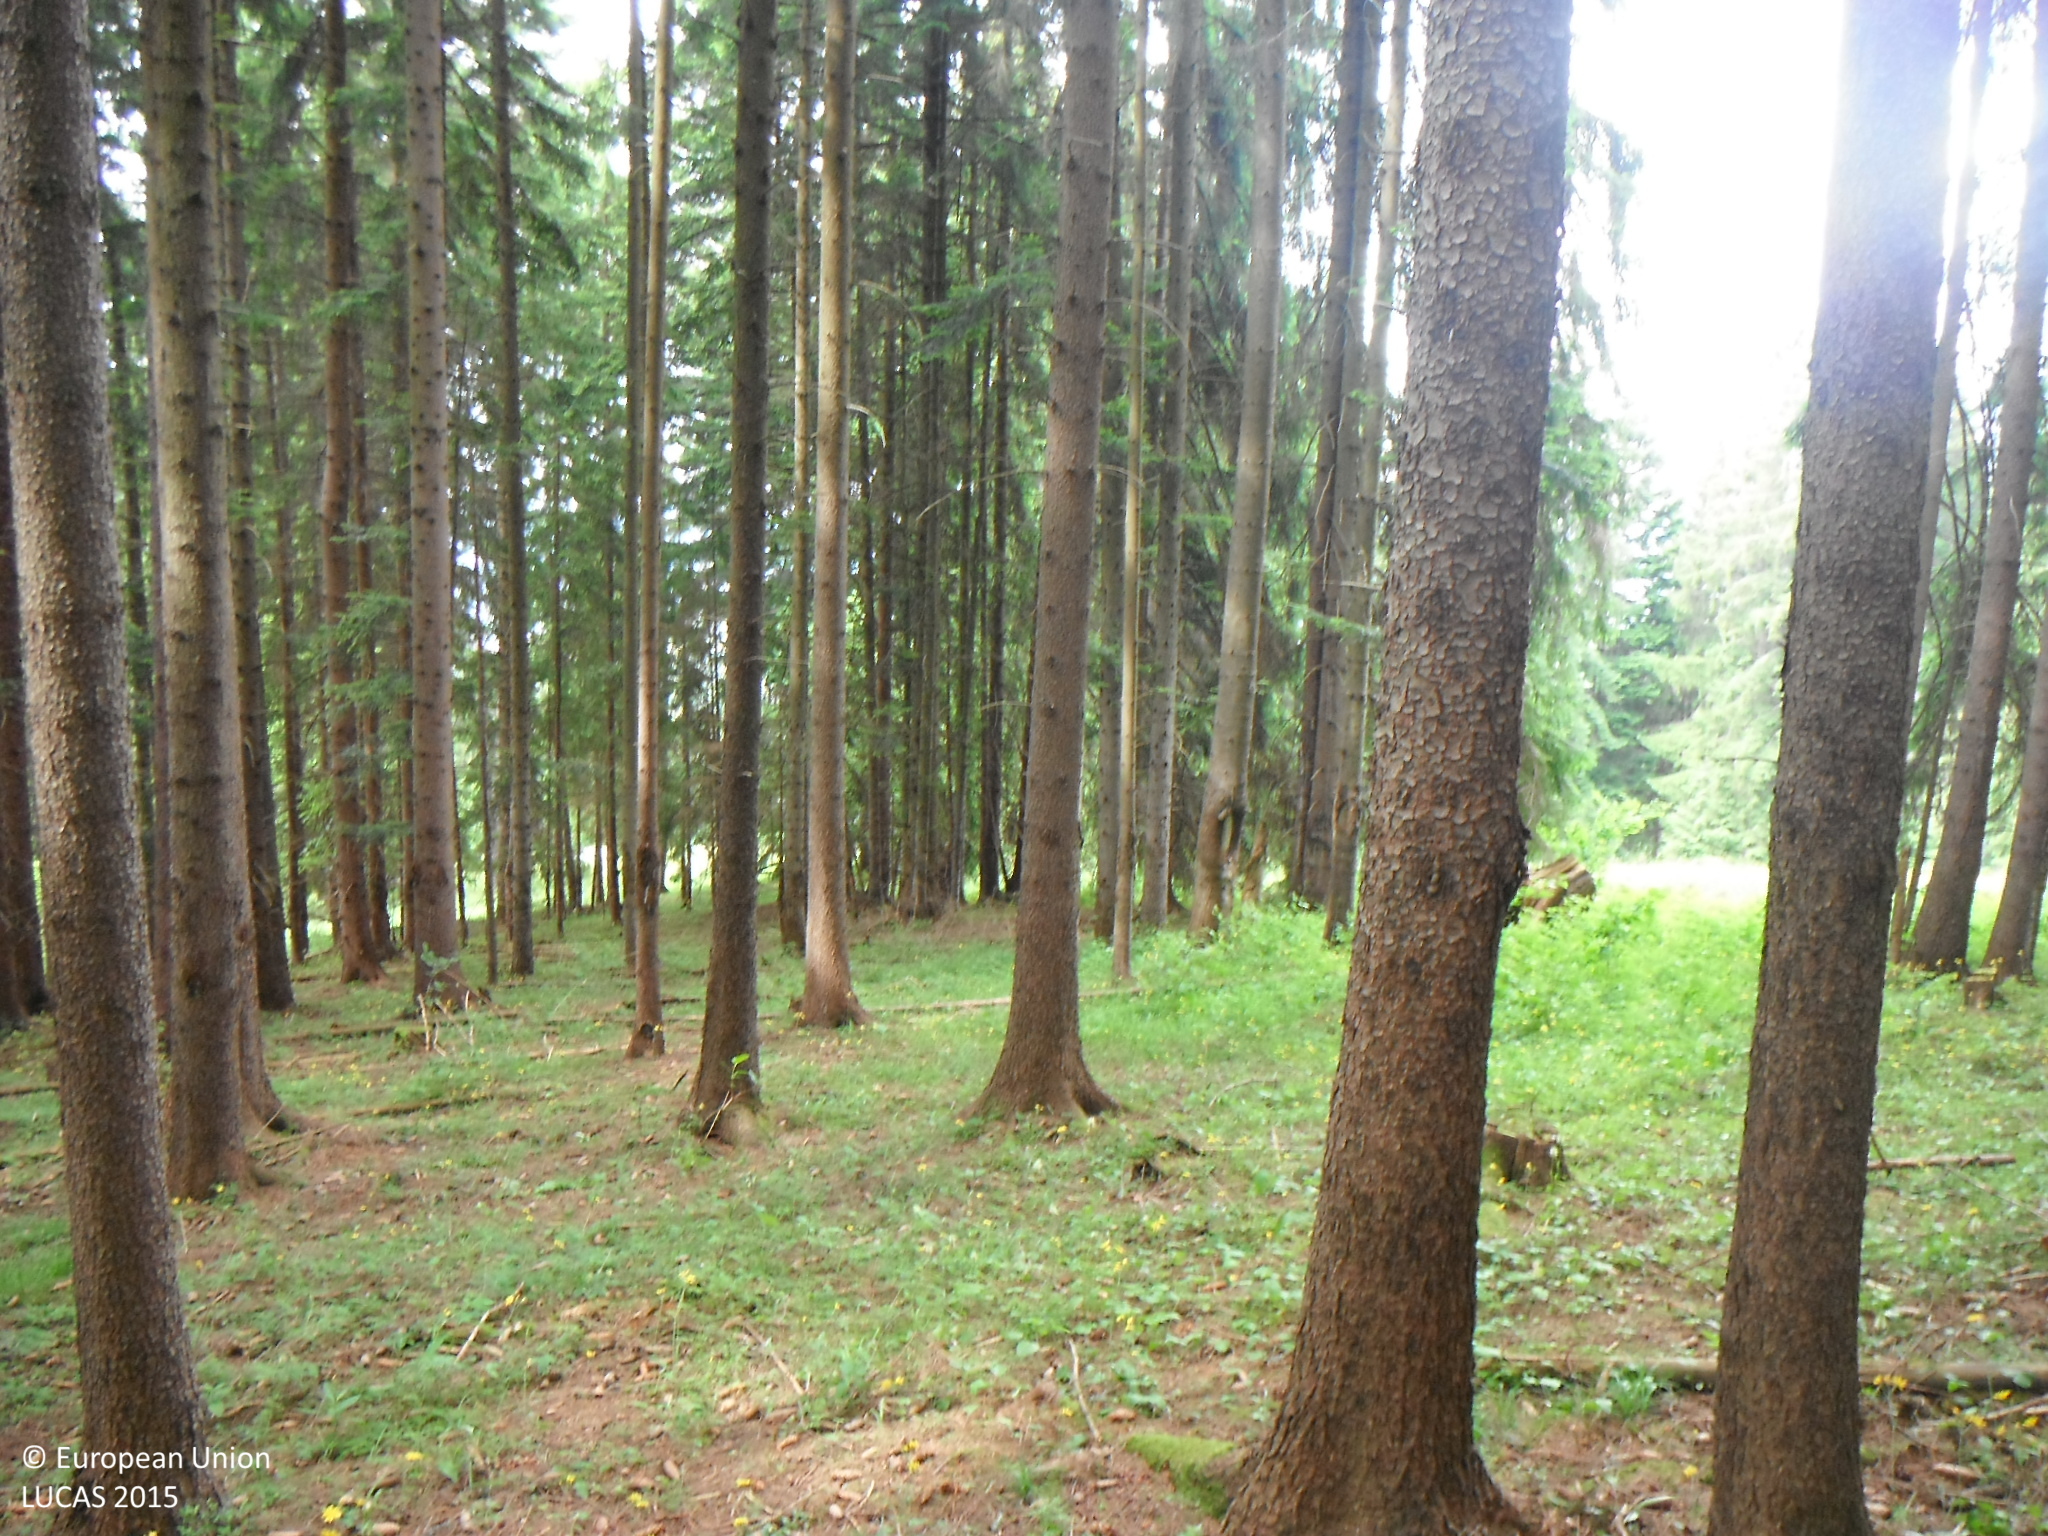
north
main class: Woodland
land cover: Spruce dominated coniferous woodland
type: alpine coniferous forest
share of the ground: > 75 %
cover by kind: coniferous forest trees 75 %, shrubs 10 %, herbaceous plants 10 %, lichens and mosses 5 %
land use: Forestry
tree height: > 5 m
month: June
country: SK
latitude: 49.0305
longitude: 19.4491
